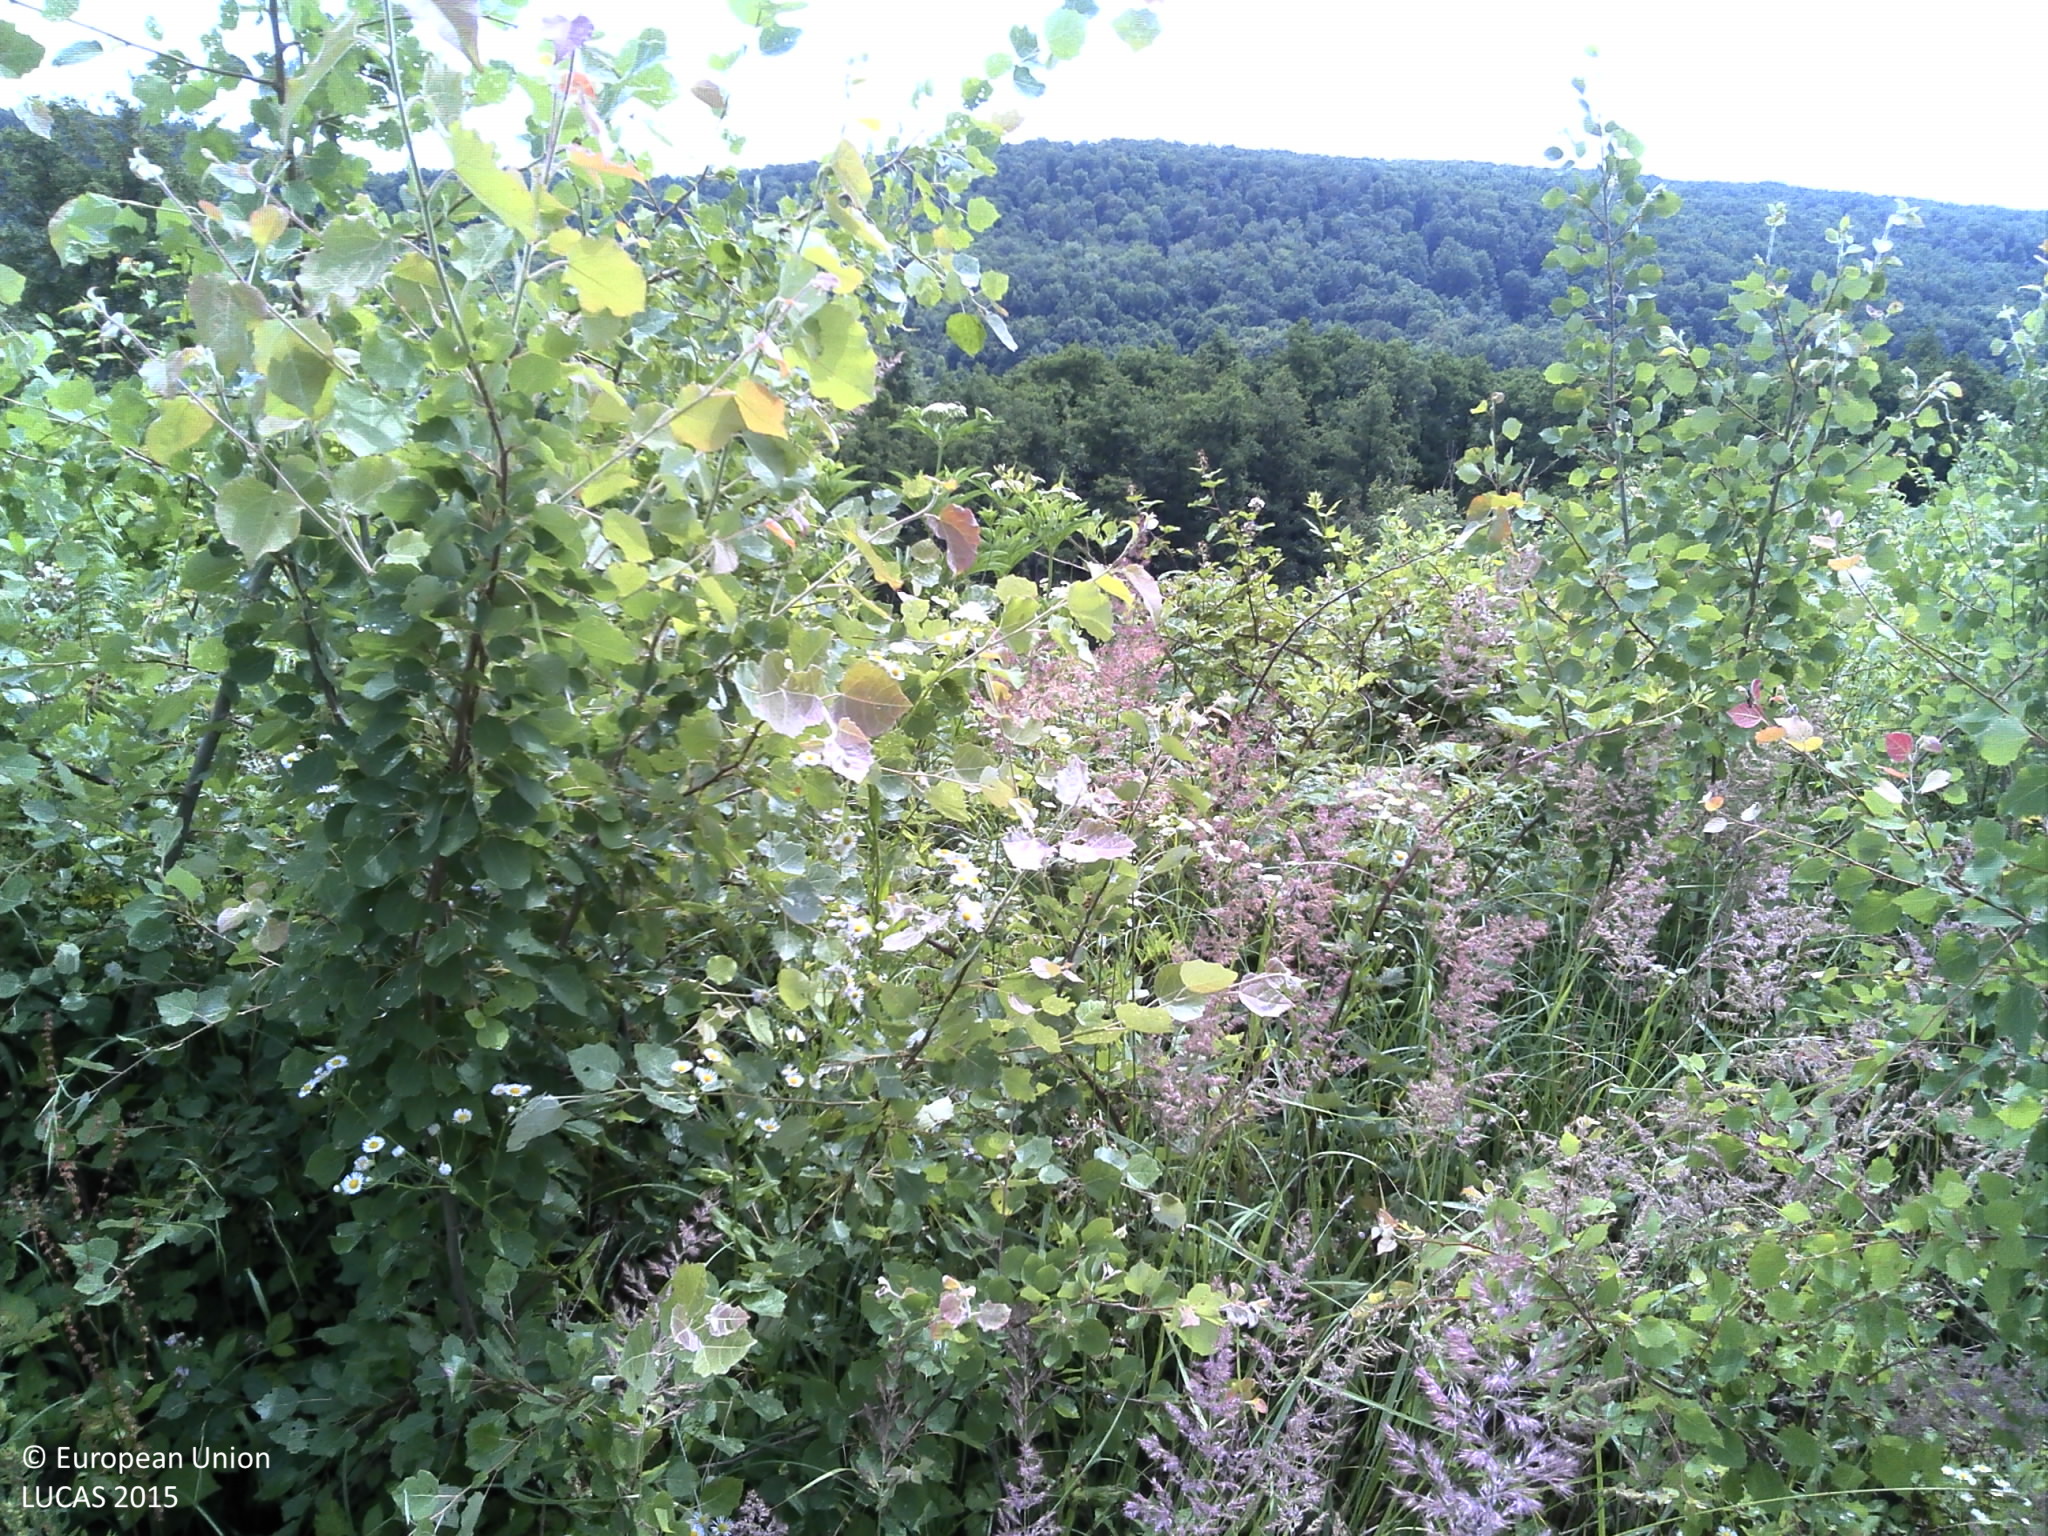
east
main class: Grassland
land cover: Spontaneously vegetated surfaces
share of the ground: > 75 %
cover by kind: herbaceous plants 90 %, shrubs 5 %, lichens and mosses 5 %
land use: Forestry
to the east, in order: Spontaneously vegetated surfaces; Tracks; Broadleaved woodland; Spontaneously vegetated surfaces
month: June
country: HR
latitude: 45.3358
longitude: 17.3889
